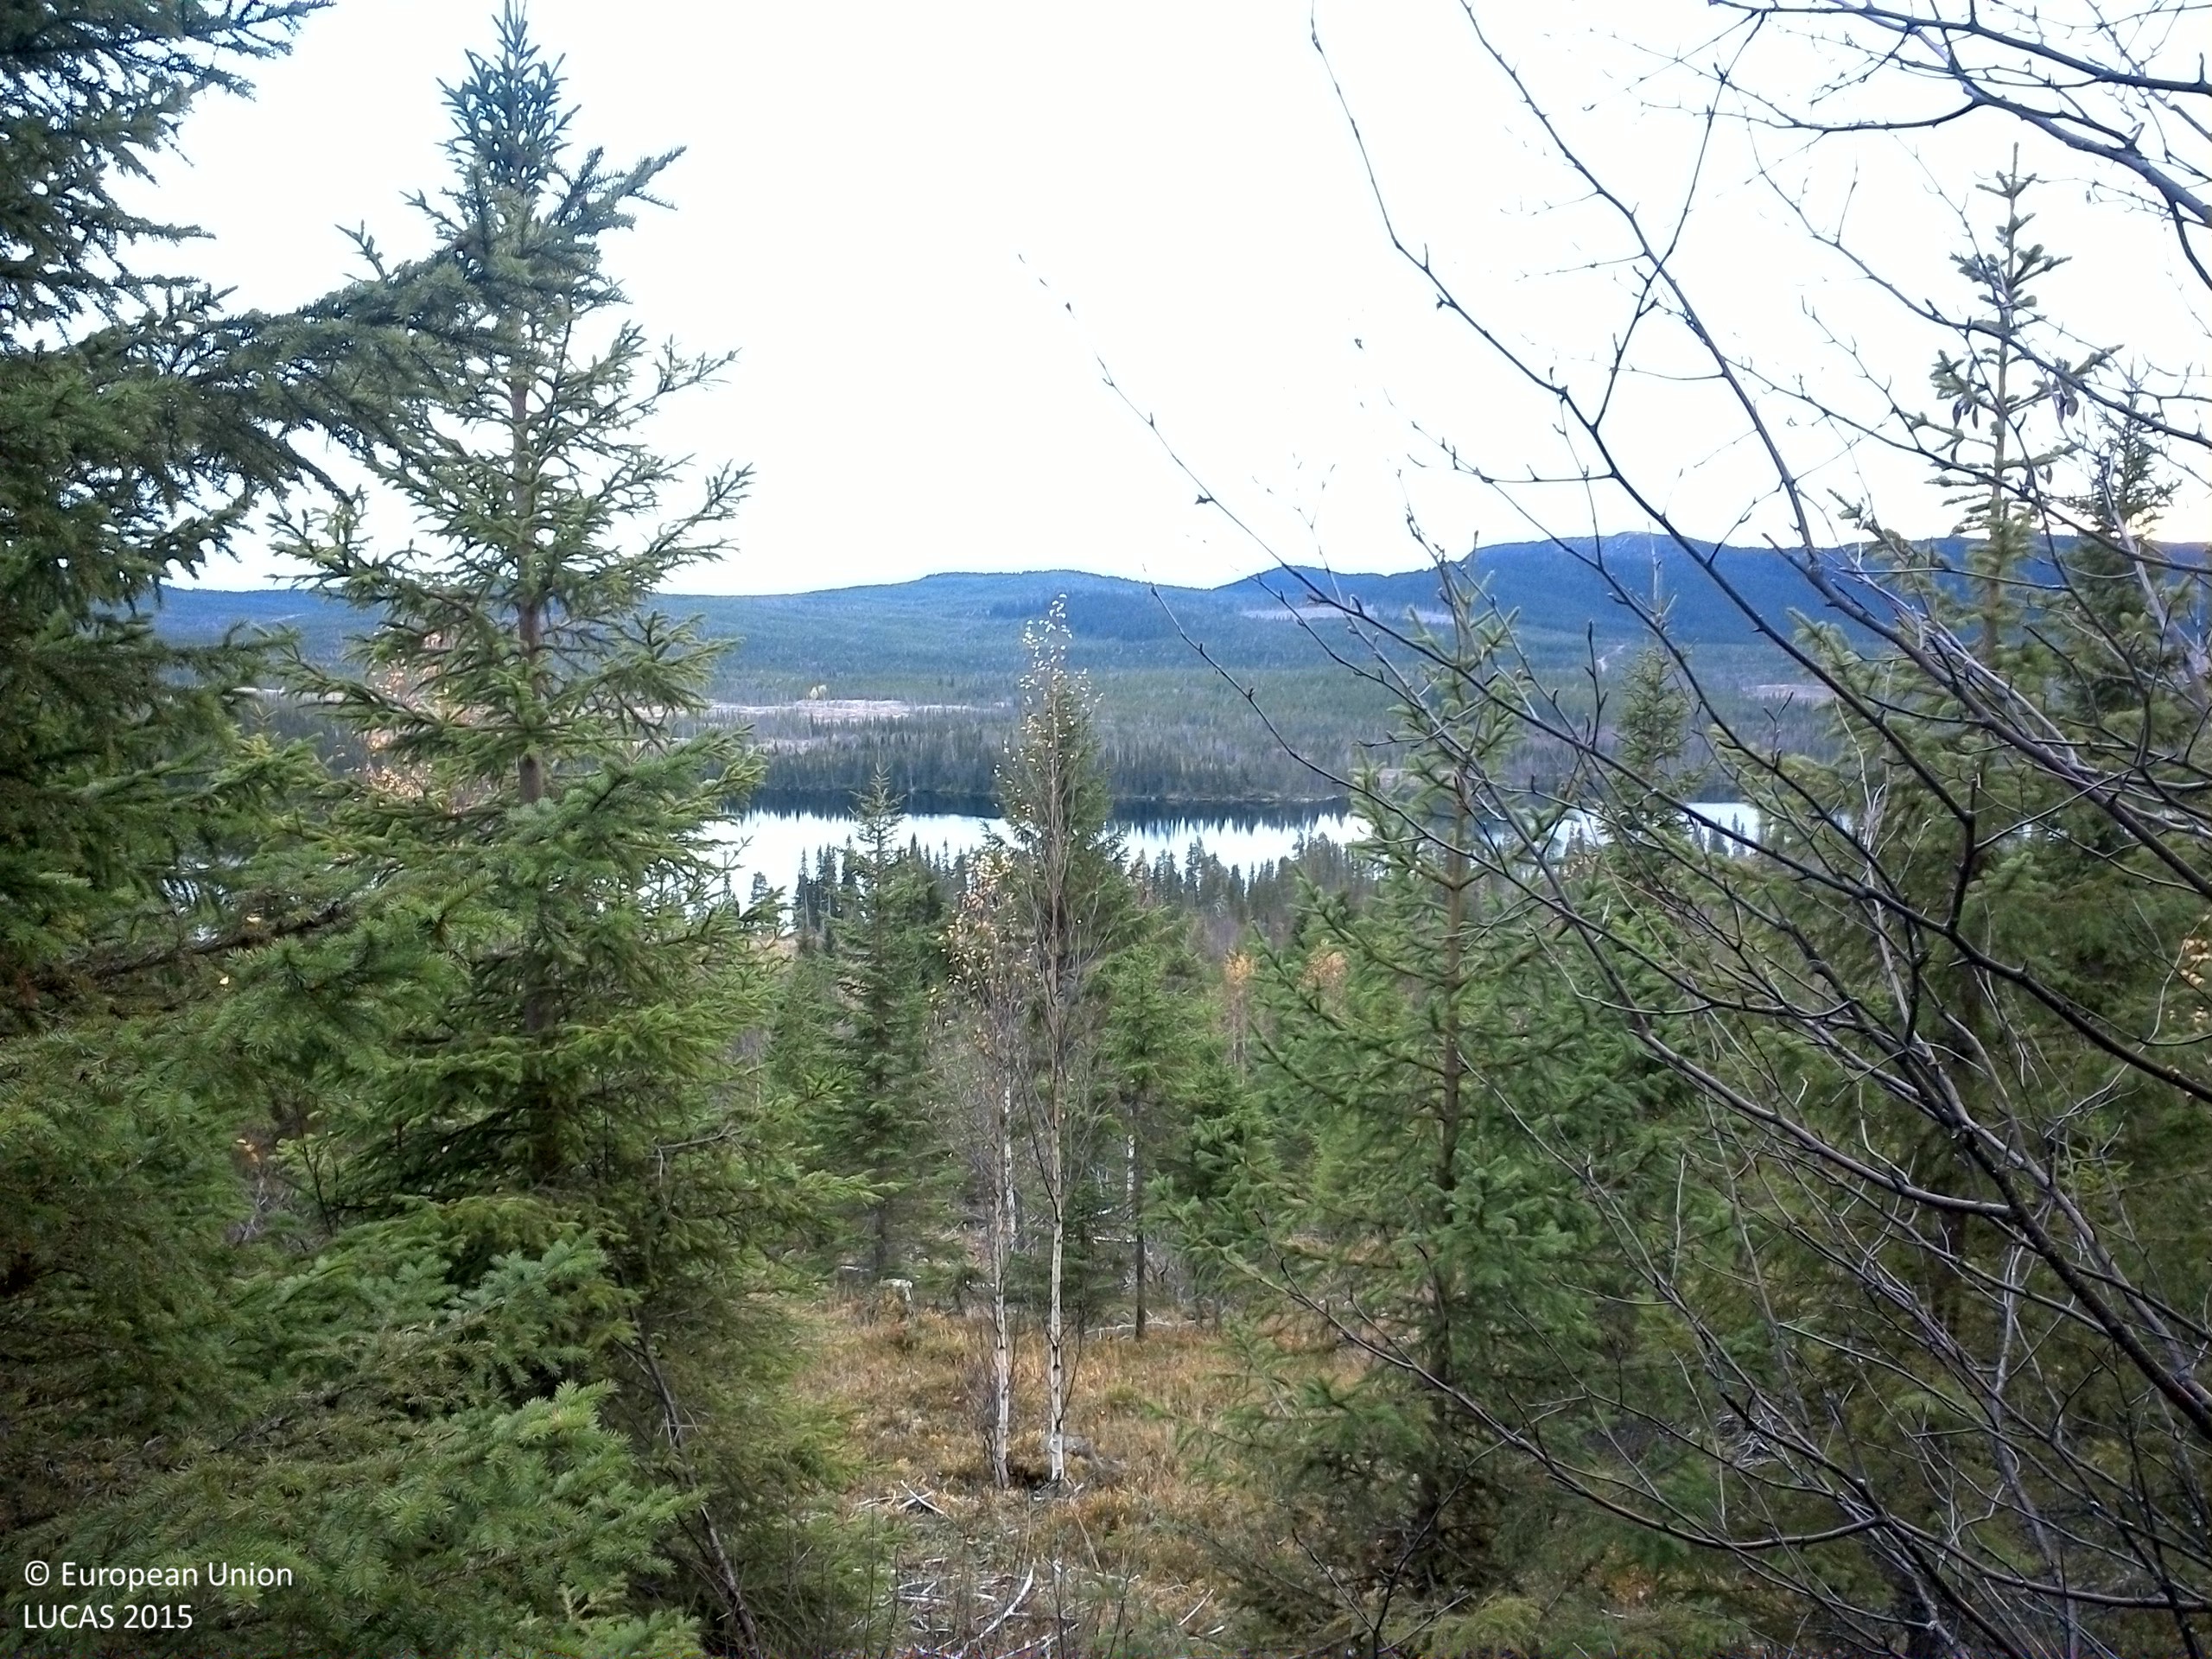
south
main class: Woodland
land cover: Spruce dominated mixed woodland
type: boreal forest
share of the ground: 50 - 75 %
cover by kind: coniferous forest trees 35 %, shrubs 35 %, broadleaved forest trees 15 %, lichens and mosses 10 %, consolidated bare surface 5 %
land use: Forestry
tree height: > 5 m
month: October
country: SE
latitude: 64.3449
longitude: 14.7554
